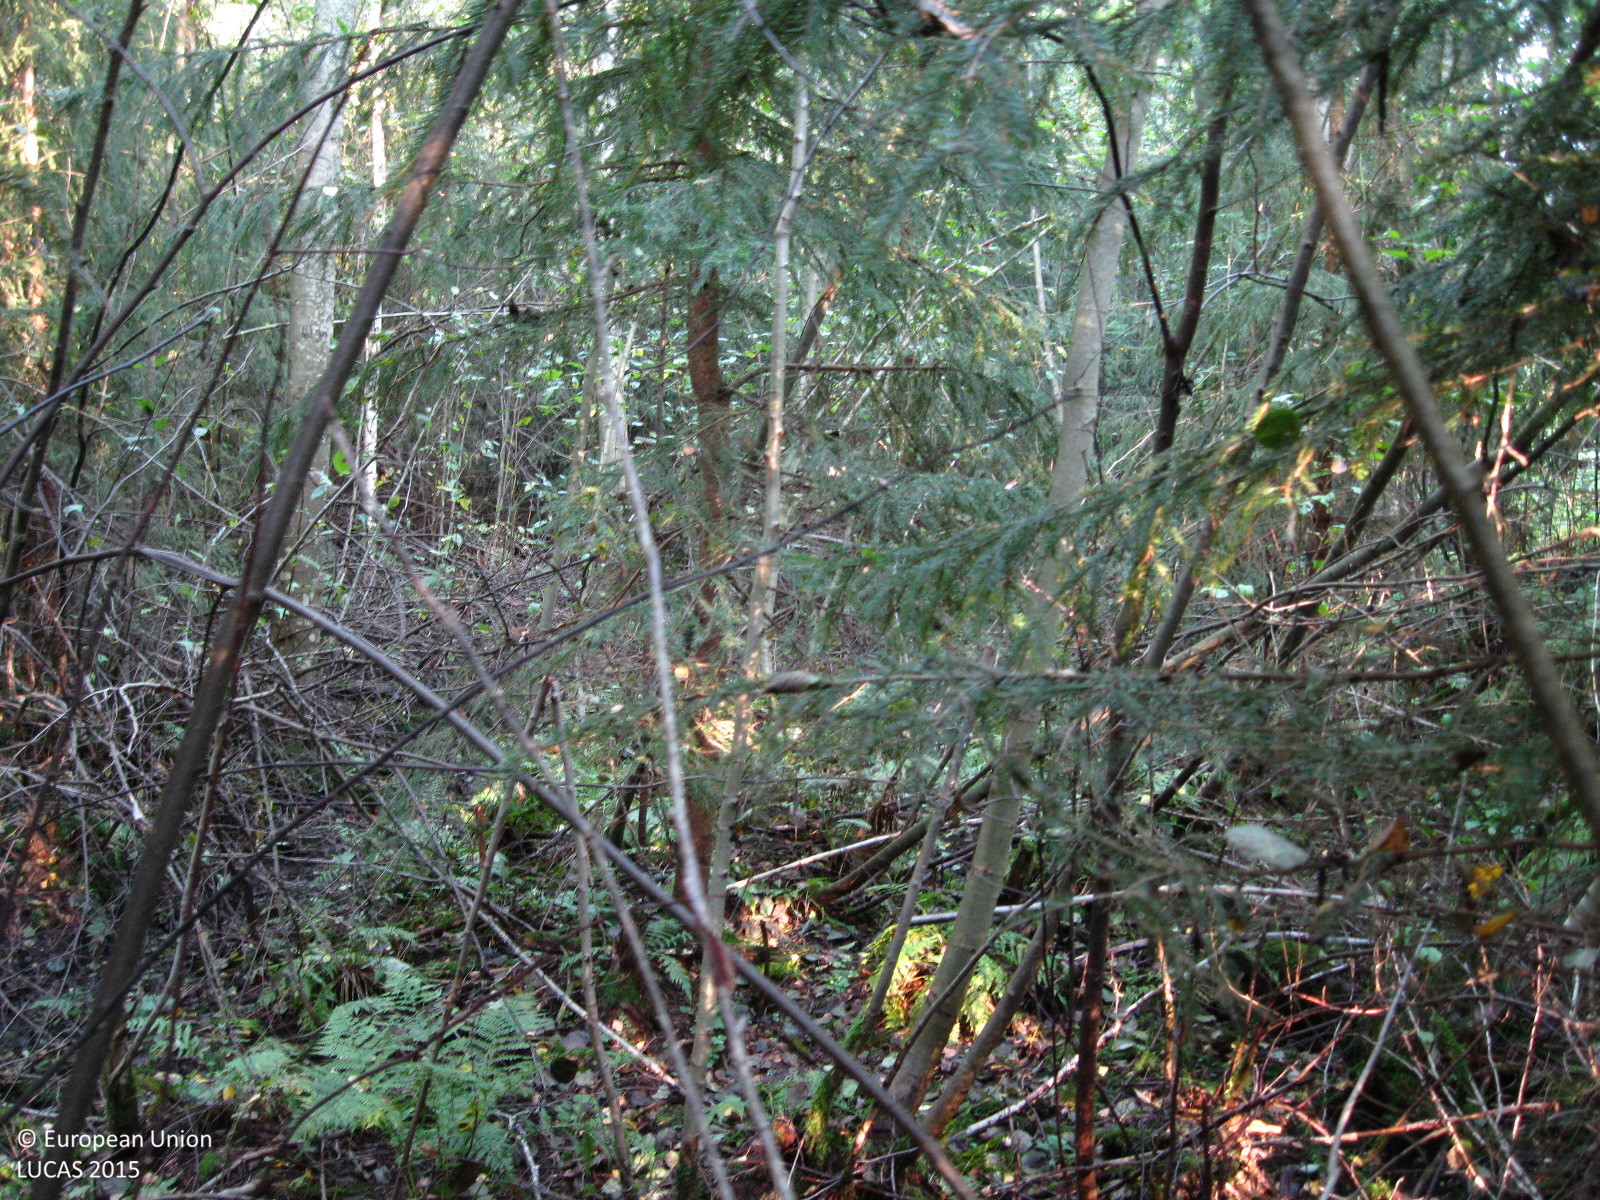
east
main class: Woodland
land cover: Spruce dominated mixed woodland
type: boreal forest
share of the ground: > 75 %
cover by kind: coniferous forest trees 50 %, broadleaved forest trees 45 %, herbaceous plants 5 %
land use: Forestry
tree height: > 5 m
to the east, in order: Spruce dominated mixed woodland; Ditches and canals; Spruce dominated mixed woodland; Ditches and canals; Spruce dominated mixed woodland; Broadleaved woodland; Ditches and canals; Broadleaved woodland; Ditches and canals; Broadleaved woodland; Ditches and canals; Broadleaved woodland; Ditches and canals; Broadleaved woodland; Ditches and canals; Broadleaved woodland; Grassland with sparse tree/shrub cover; Electric lines; Grassland with sparse tree/shrub cover; Spruce dominated mixed woodland; Fences; Spruce dominated mixed woodland; Artificial constructions in urban areas; Grassland without tree/shrub cover; Fences; Spruce dominated mixed woodland; Shrubland without tree cover
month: September
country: FI
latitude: 60.5555
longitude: 24.7555
